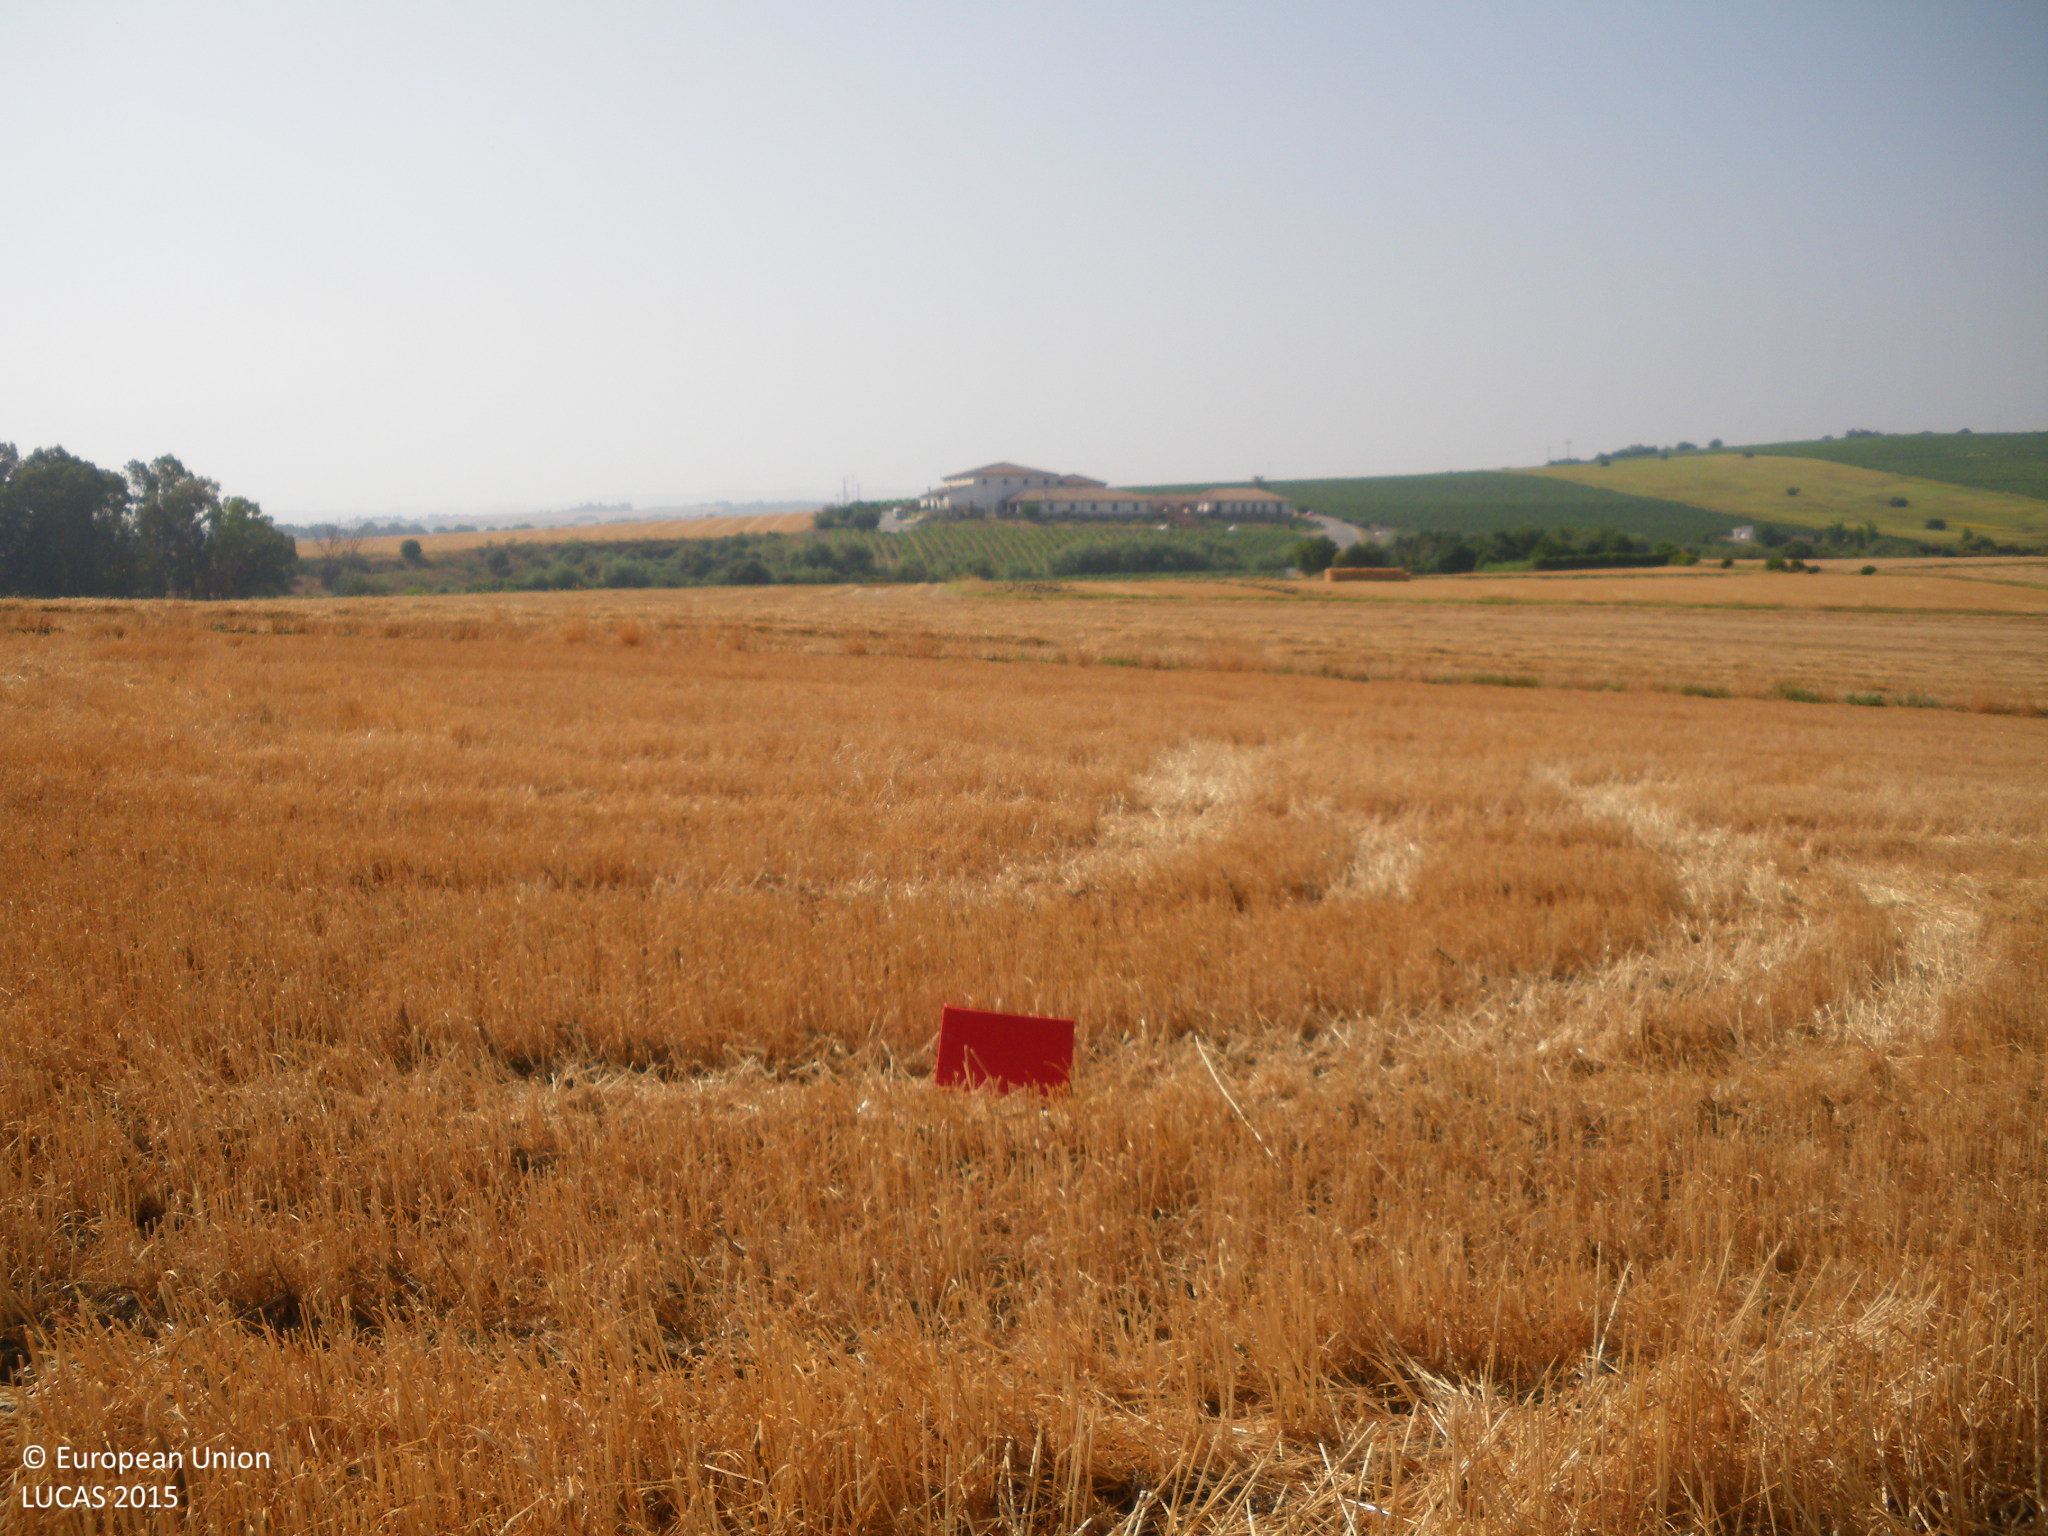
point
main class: Cropland
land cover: Common wheat
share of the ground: < 10 %
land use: Agriculture (excluding fallow land and kitchen gardens)
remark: Harvested field
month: July
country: ES
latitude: 36.7838
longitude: -5.7063
